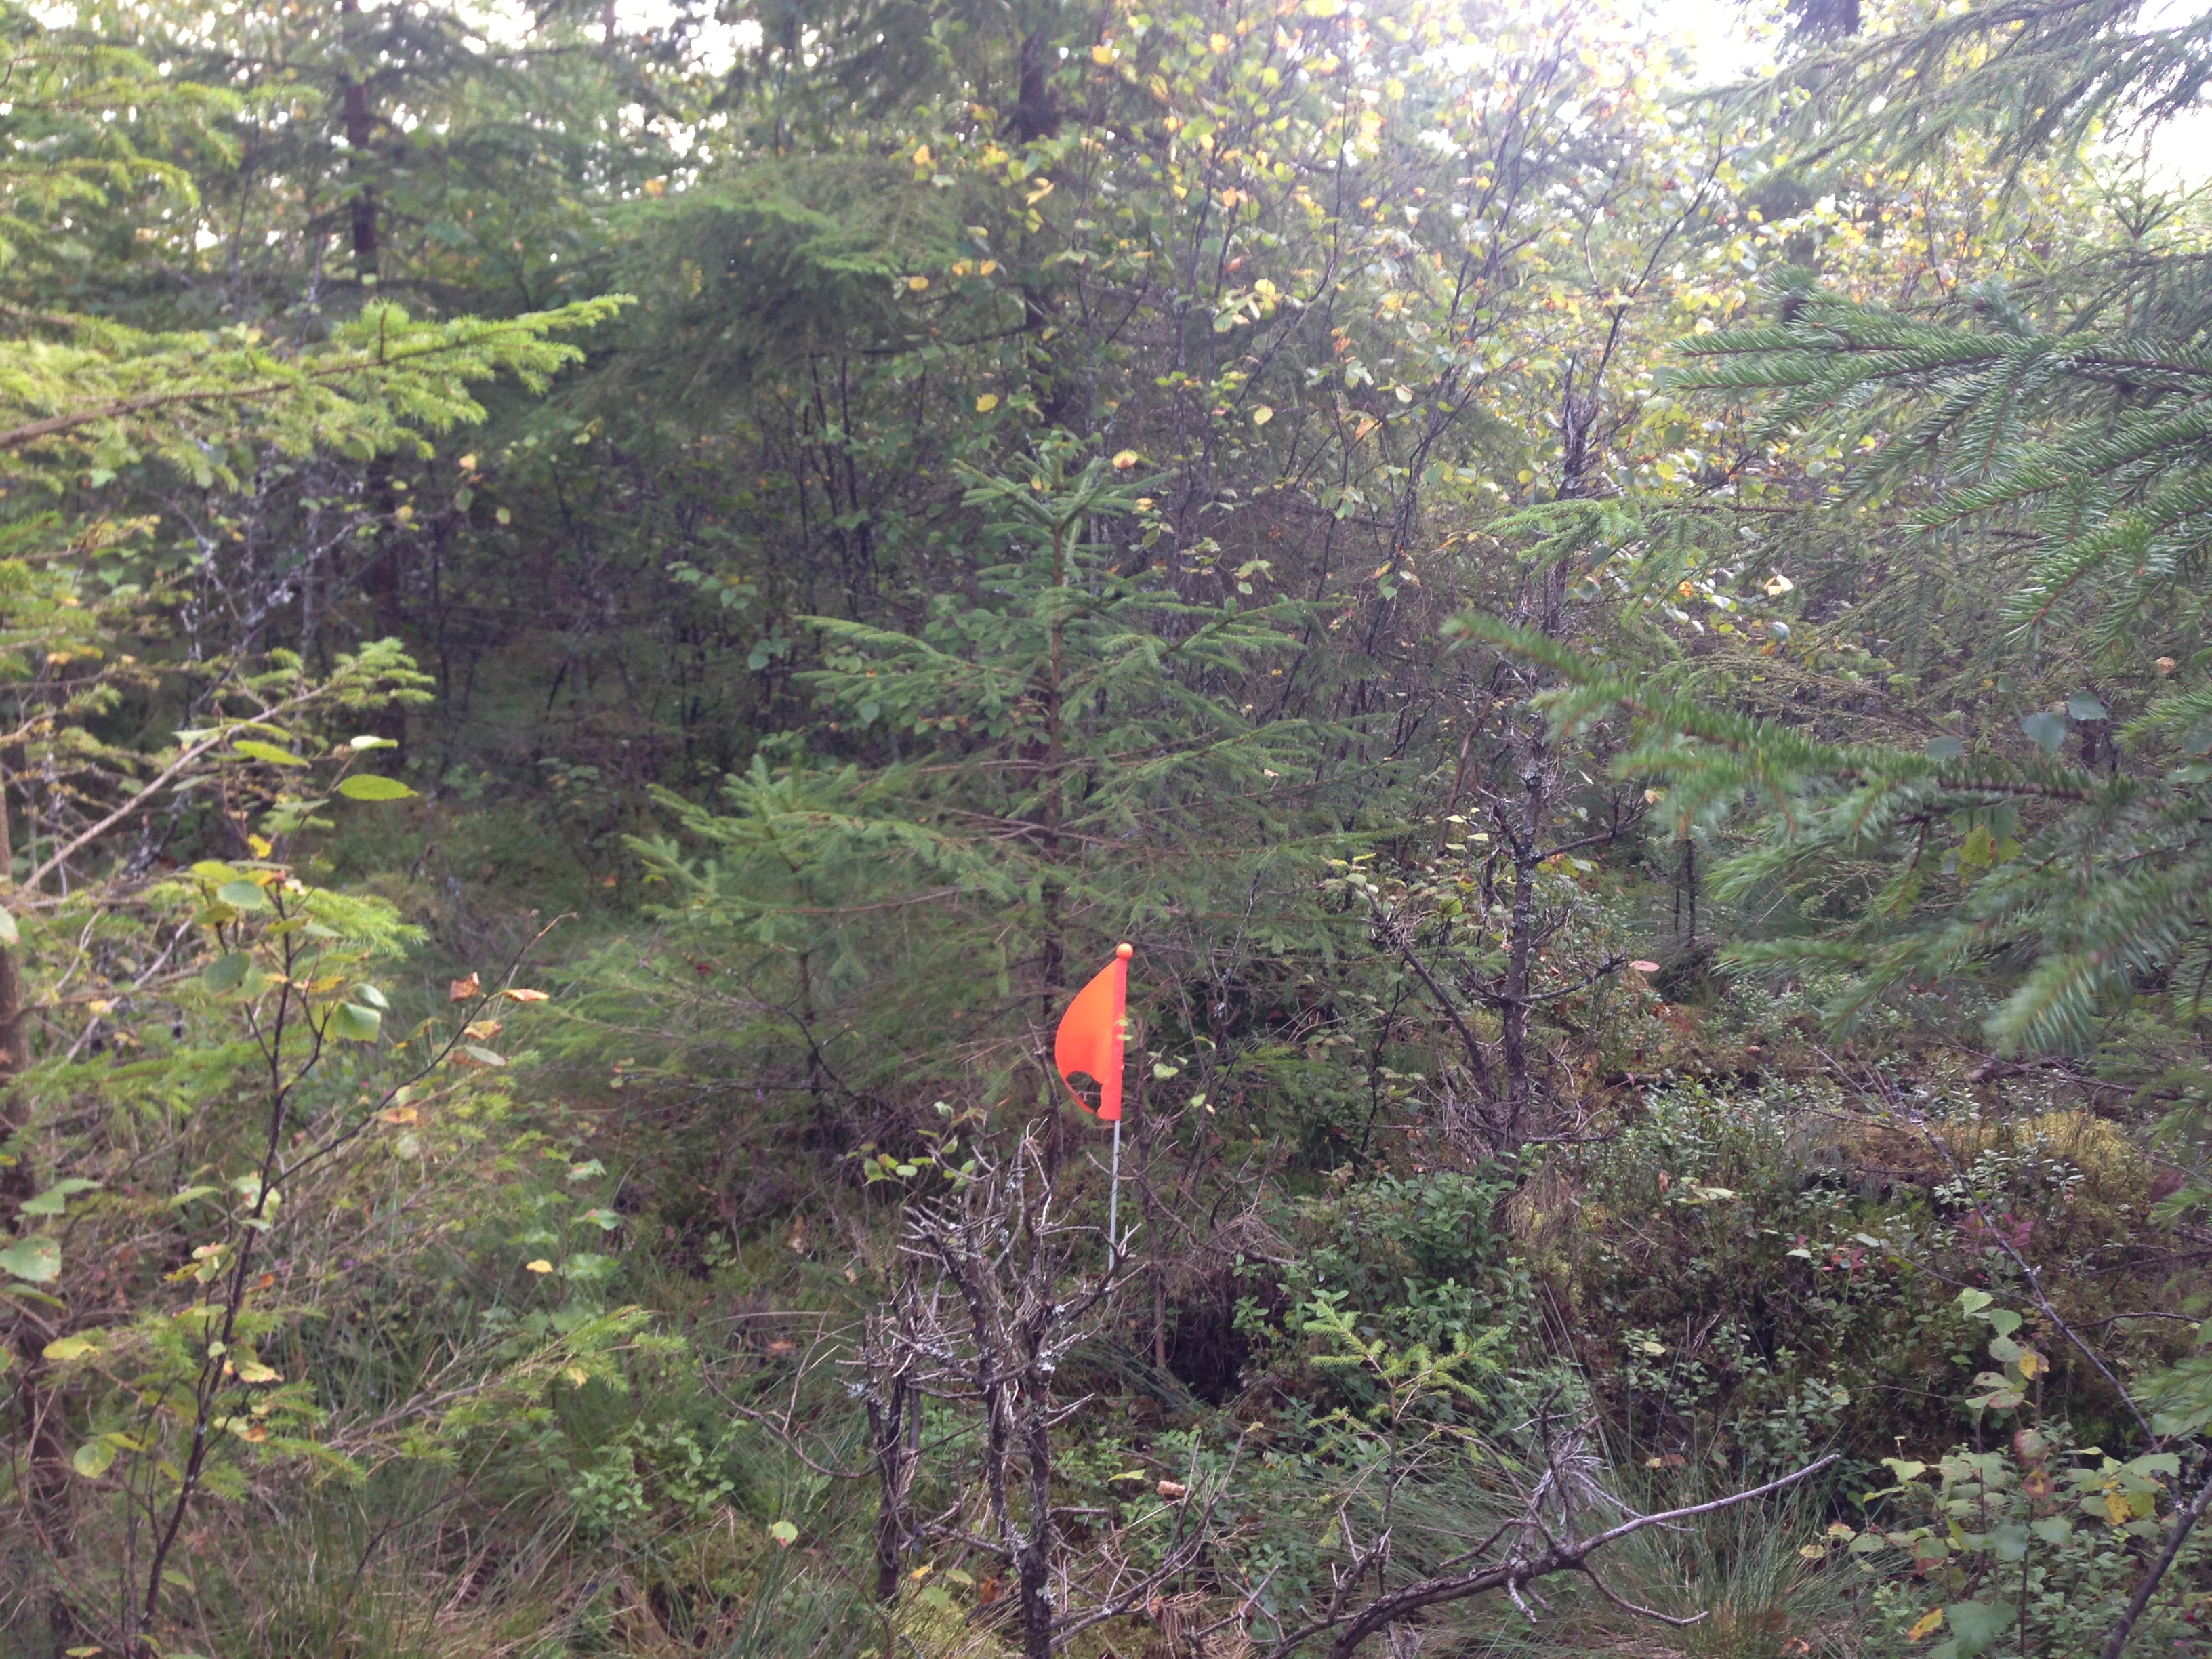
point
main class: Woodland
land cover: Spruce dominated mixed woodland
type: boreal forest
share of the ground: > 75 %
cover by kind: coniferous forest trees 60 %, broadleaved forest trees 20 %, shrubs 20 %
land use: Forestry
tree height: > 5 m
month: September
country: SE
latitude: 57.1207
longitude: 13.1508
